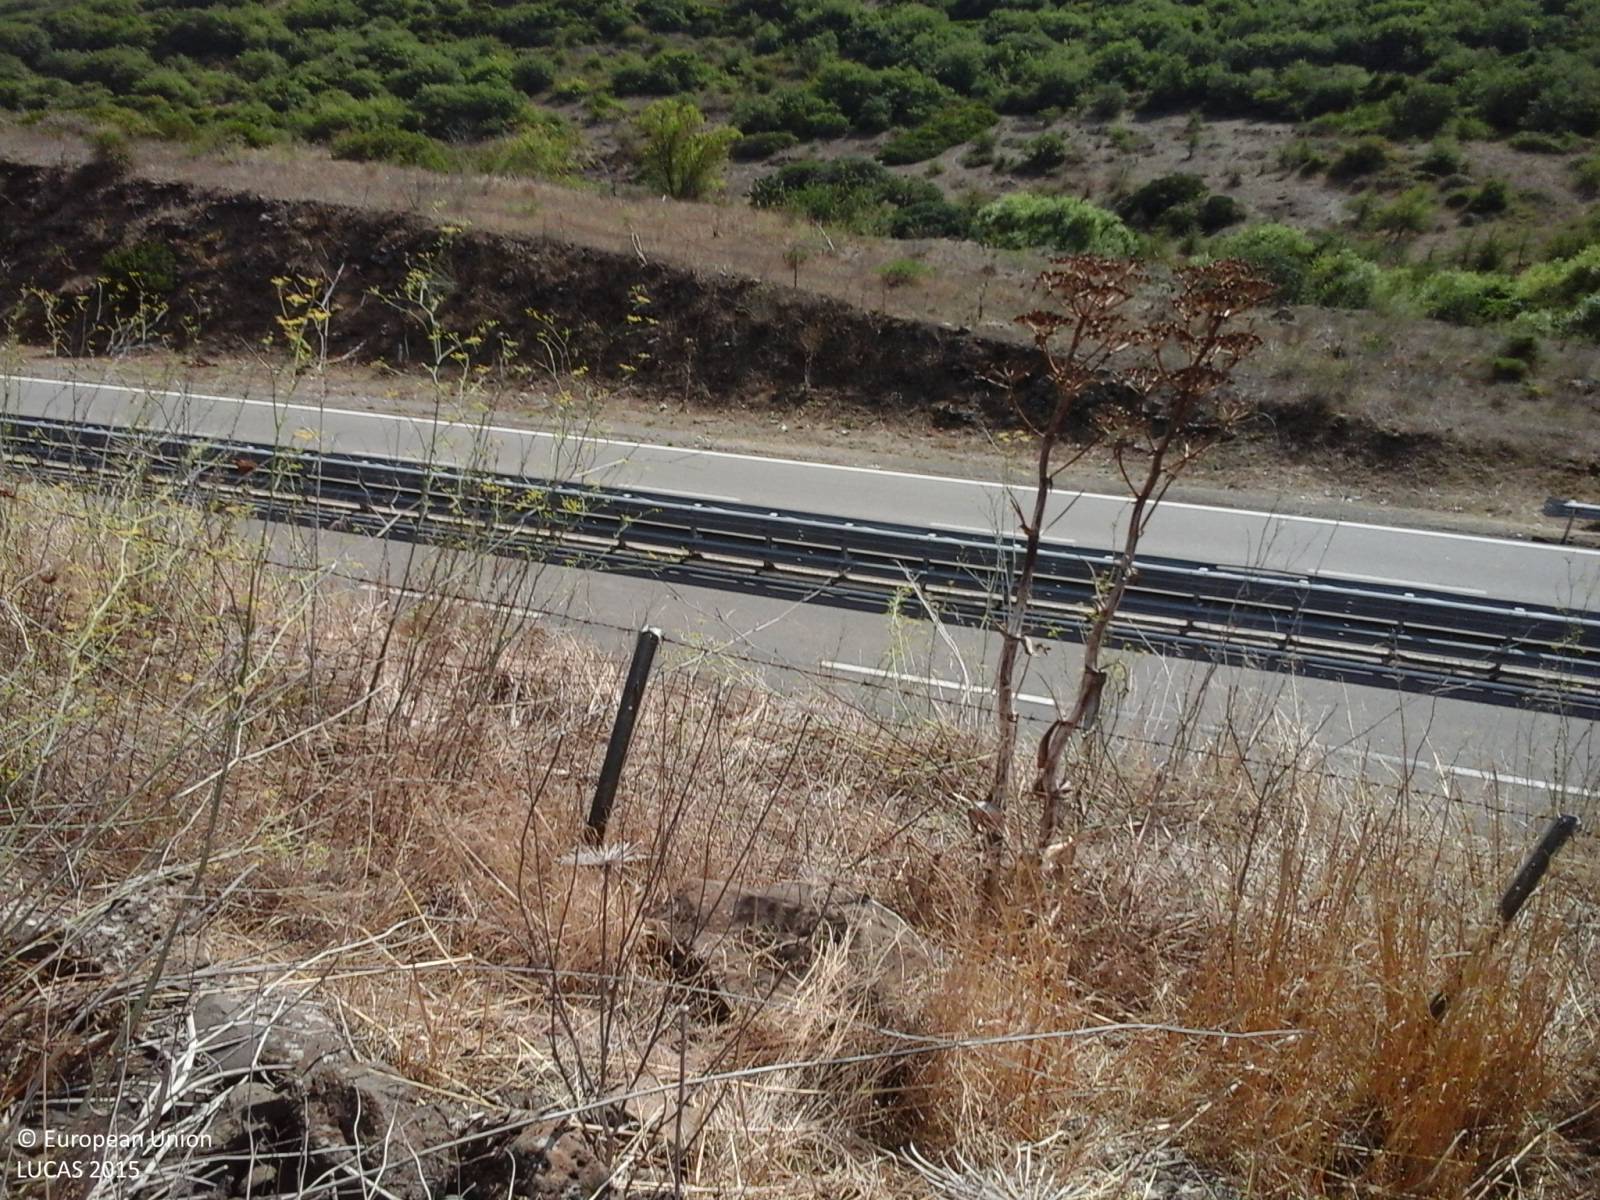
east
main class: Grassland
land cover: Grassland without tree/shrub cover
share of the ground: > 75 %
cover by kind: herbaceous plants 100 %
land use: Agriculture (excluding fallow land and kitchen gardens)
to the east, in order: Grassland without tree/shrub cover; Abandoned hedges; Rivers and streams; Abandoned hedges; Grassland with sparse tree/shrub cover; Broadleaved woodland
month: August
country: IT
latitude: 40.1341
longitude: 8.8676
